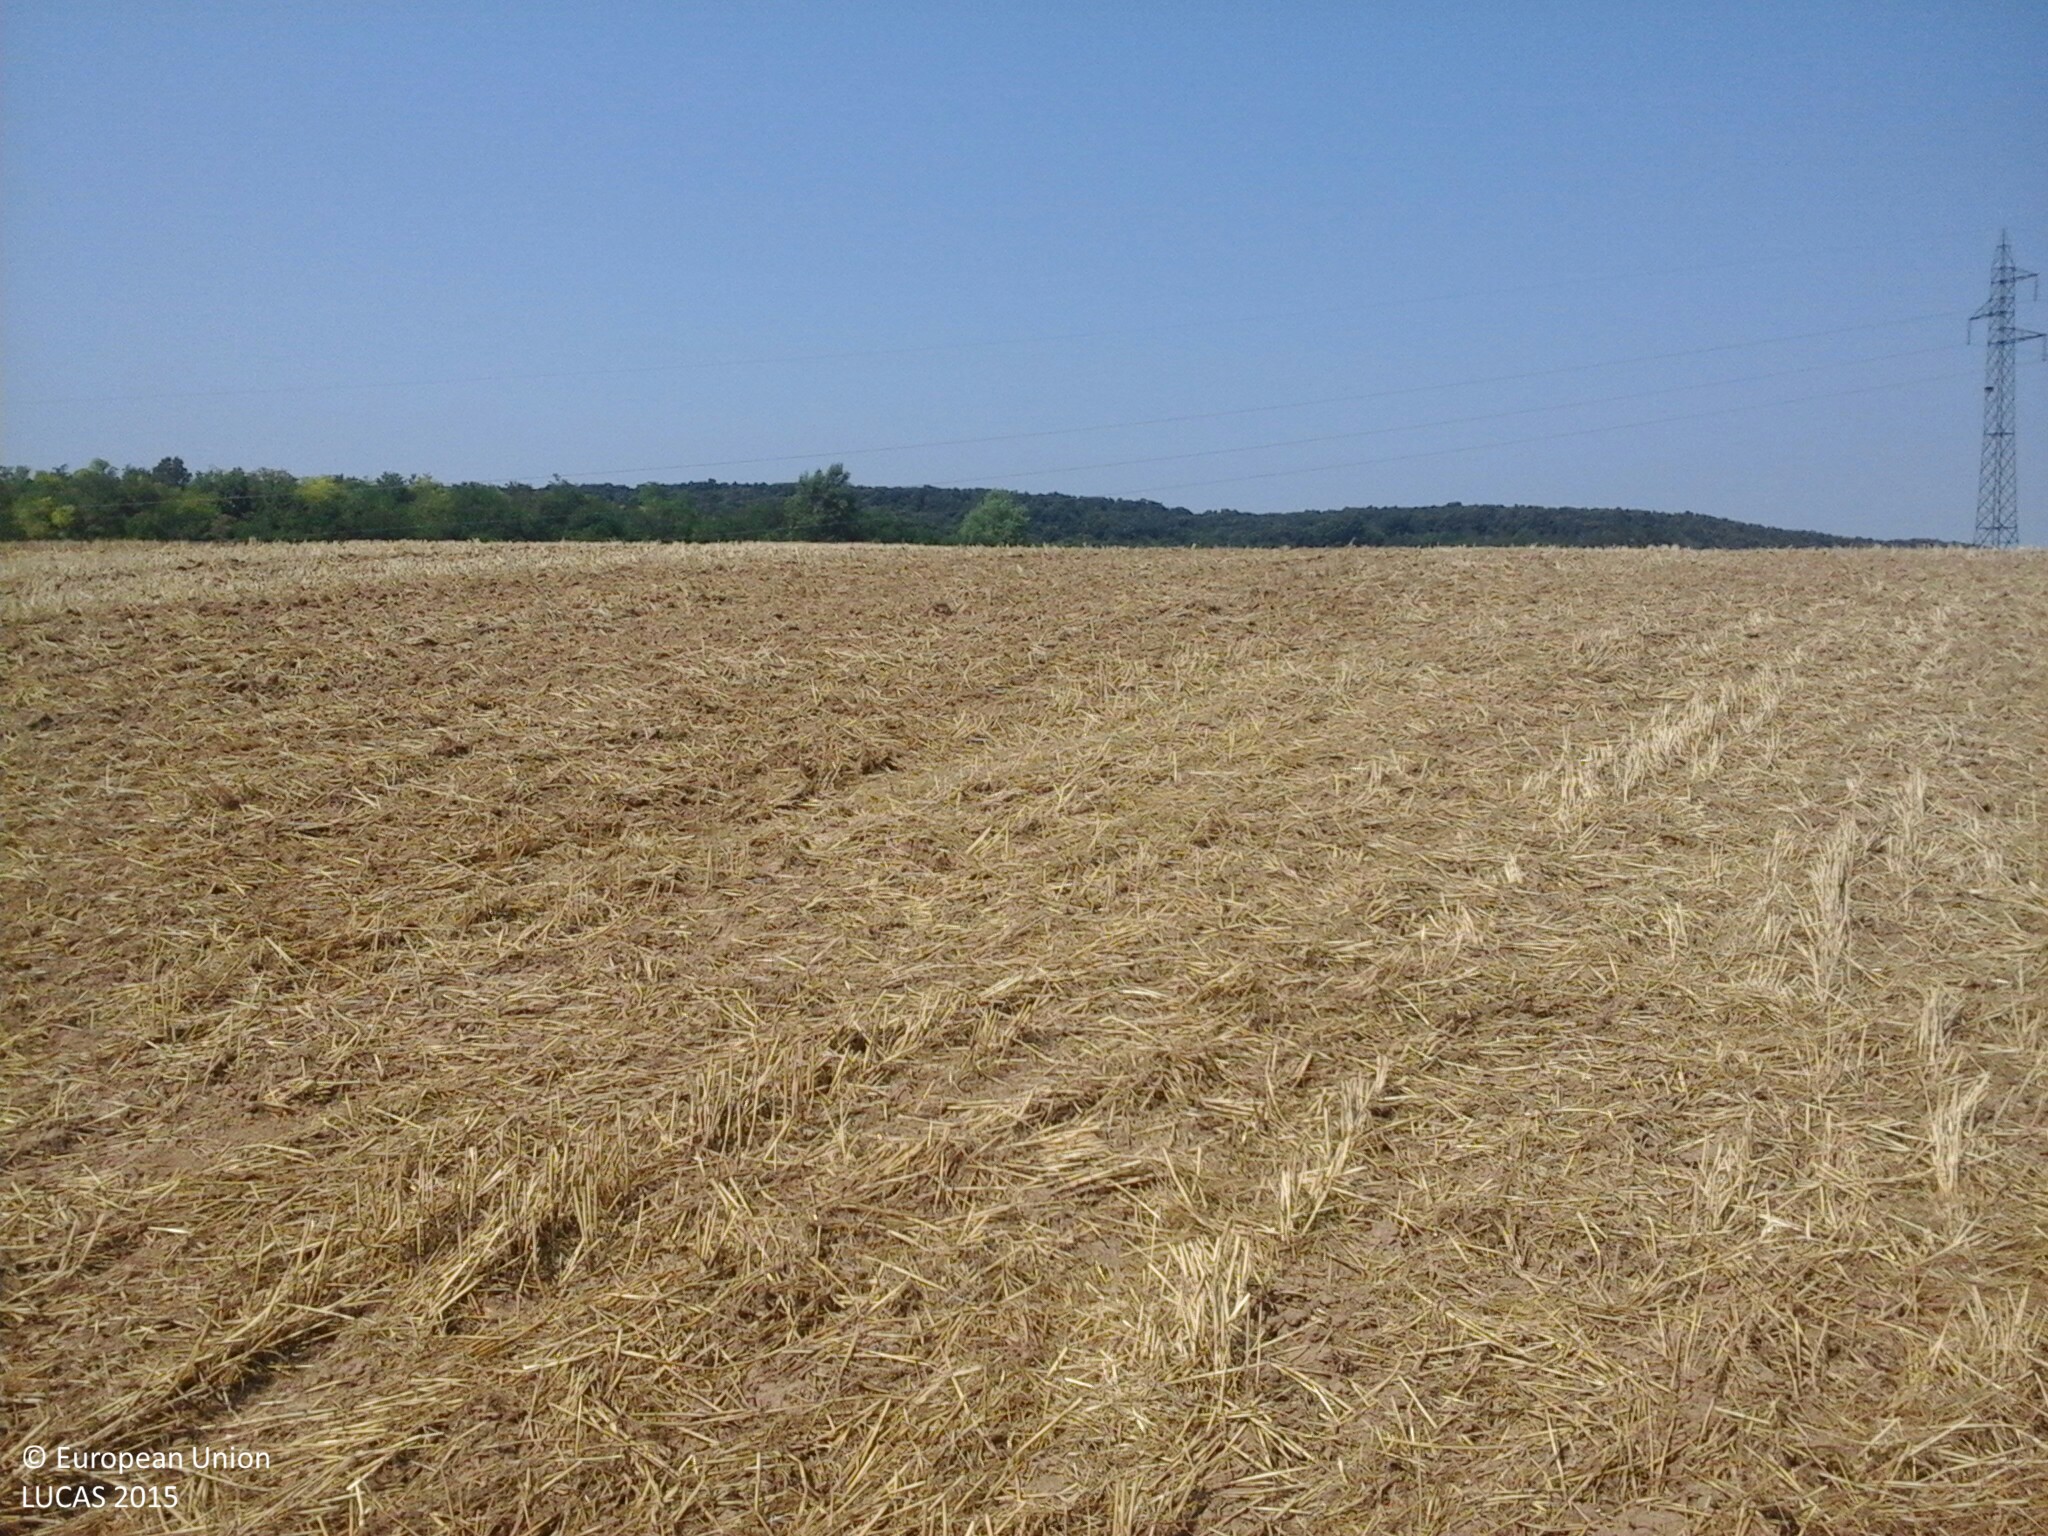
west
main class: Cropland
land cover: Common wheat
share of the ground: 10 - 25 %
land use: Agriculture (excluding fallow land and kitchen gardens)
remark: Harvested field
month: August
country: HU
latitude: 47.3406
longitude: 18.1775
